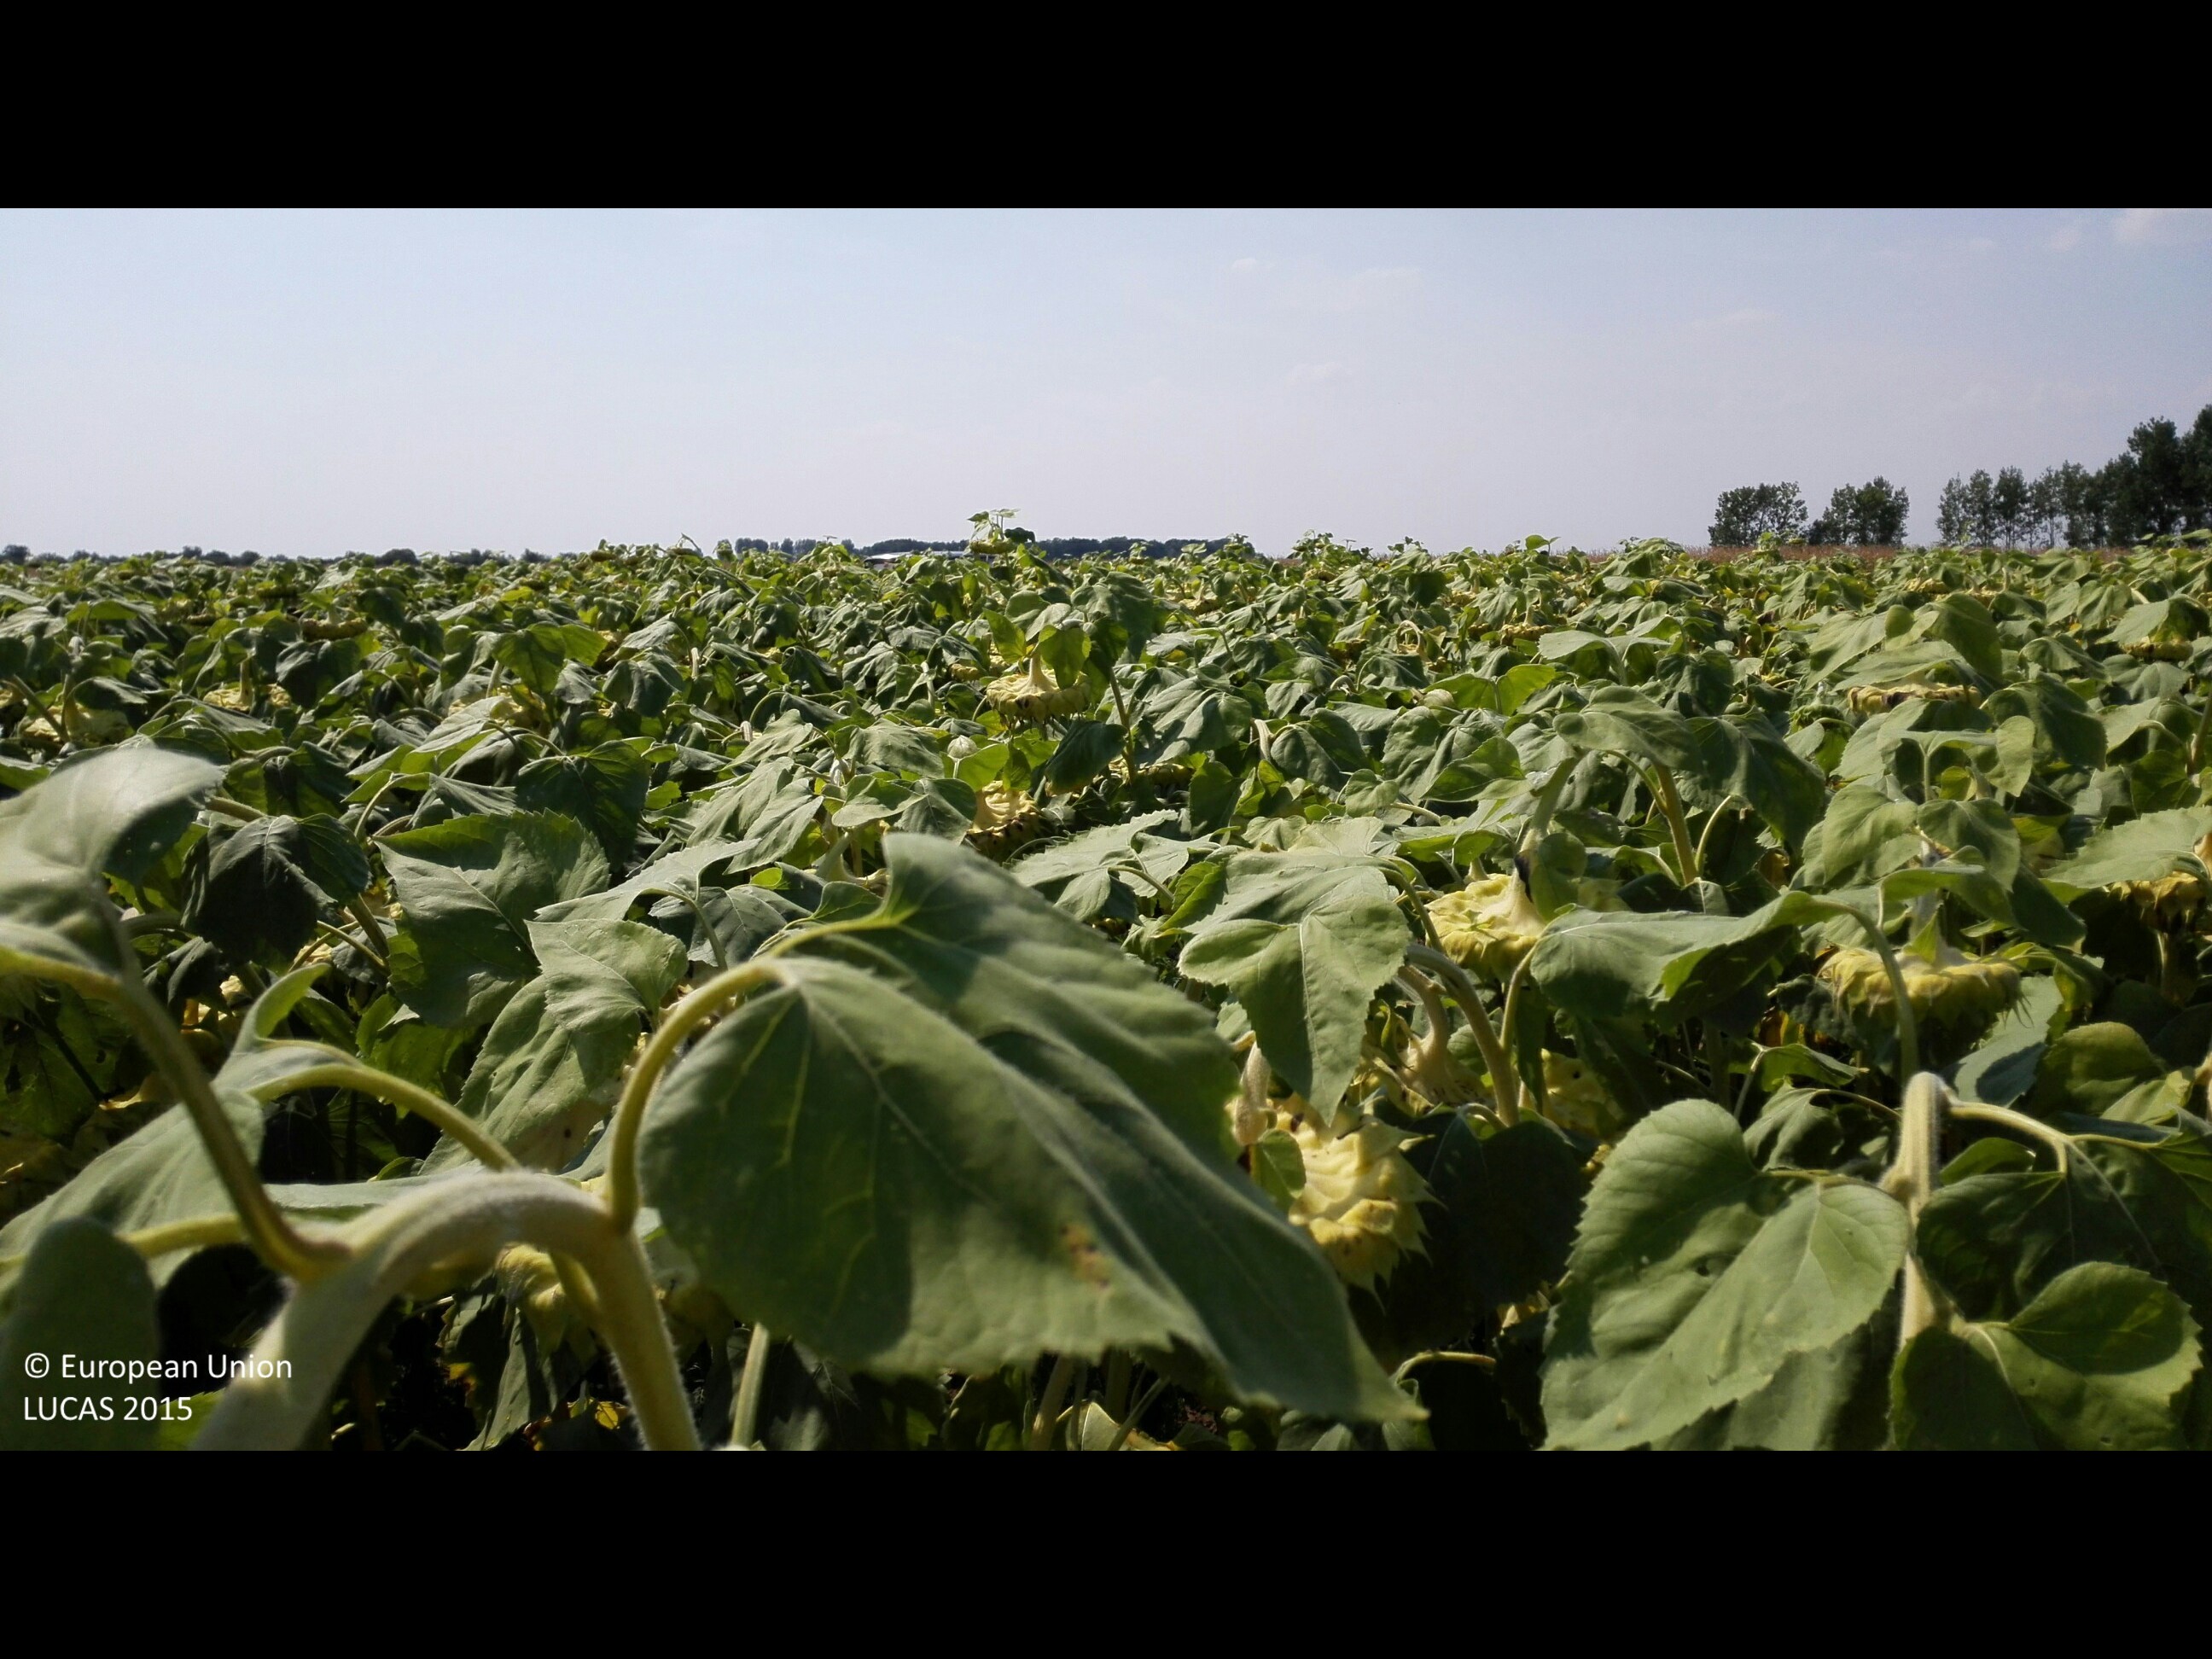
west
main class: Cropland
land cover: Sunflower
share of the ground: > 75 %
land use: Agriculture (excluding fallow land and kitchen gardens)
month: August
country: HU
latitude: 47.3748
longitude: 21.5786
